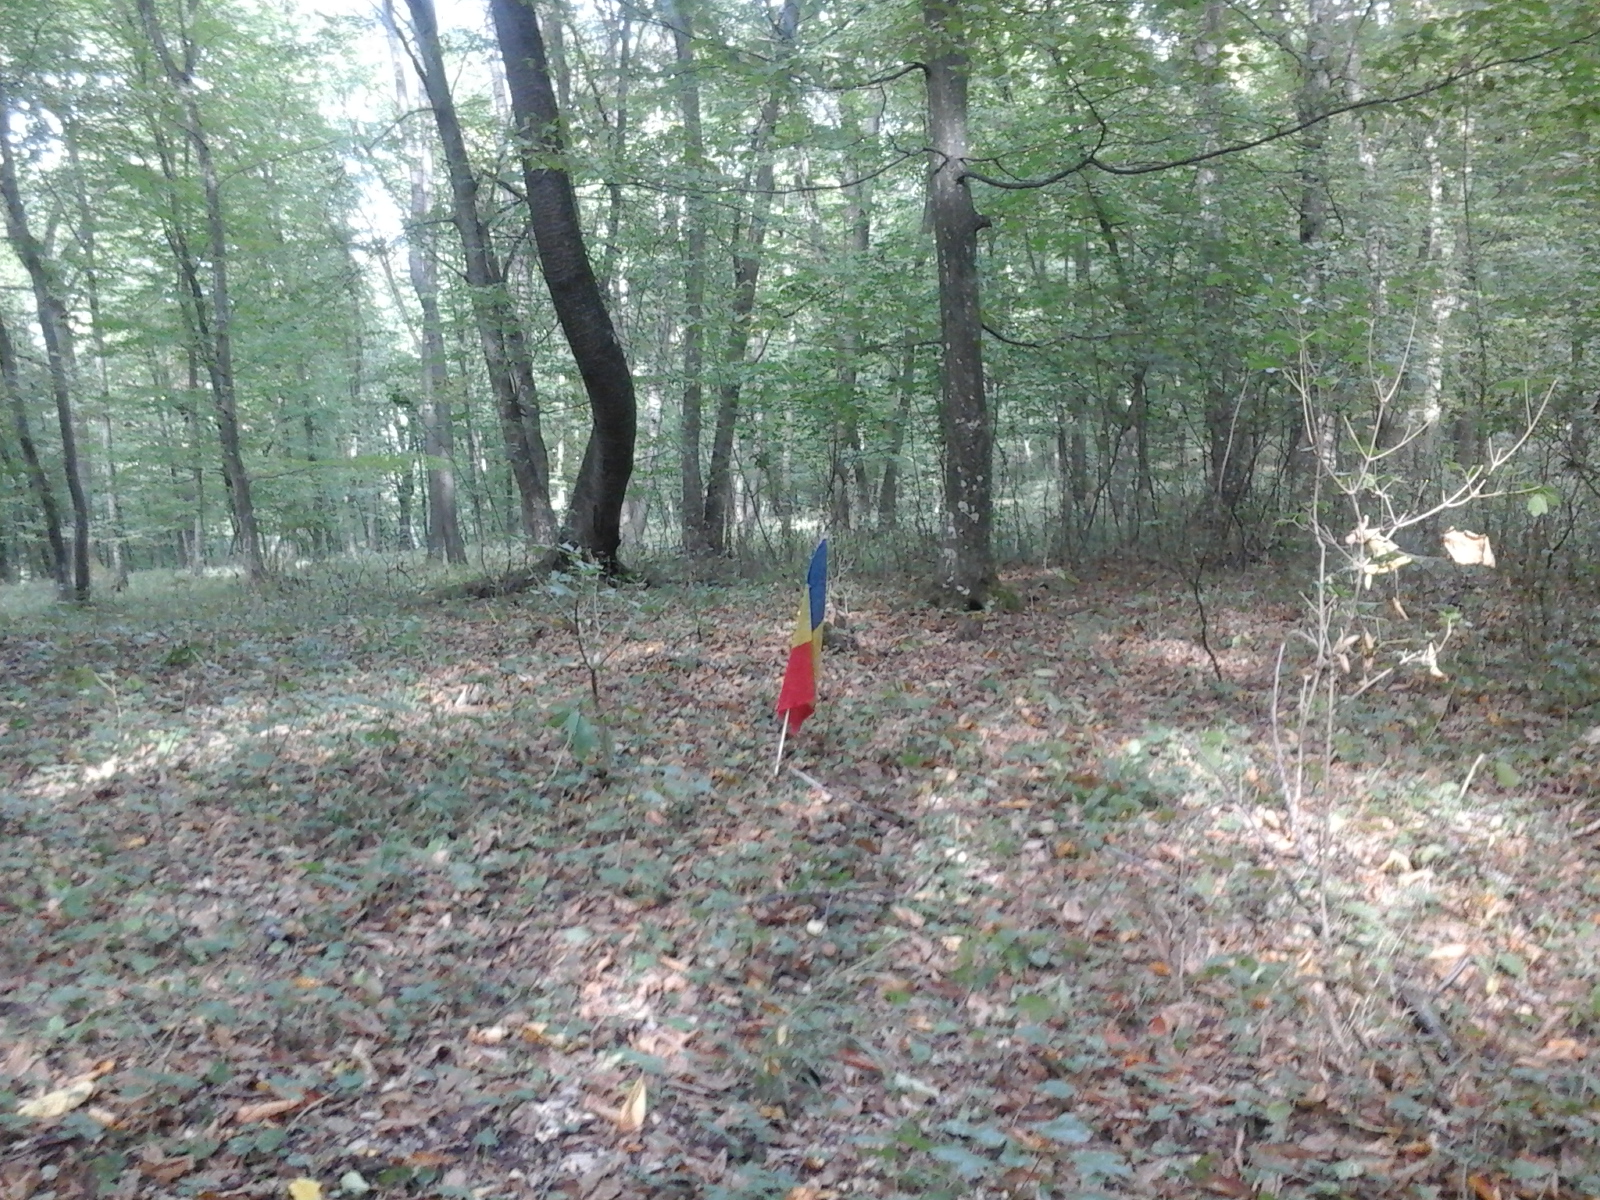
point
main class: Woodland
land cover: Broadleaved woodland
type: mesophytic deciduous forest
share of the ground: > 75 %
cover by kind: broadleaved forest trees 100 %
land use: Forestry
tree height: > 5 m
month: September
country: RO
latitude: 46.9286
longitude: 24.0952
